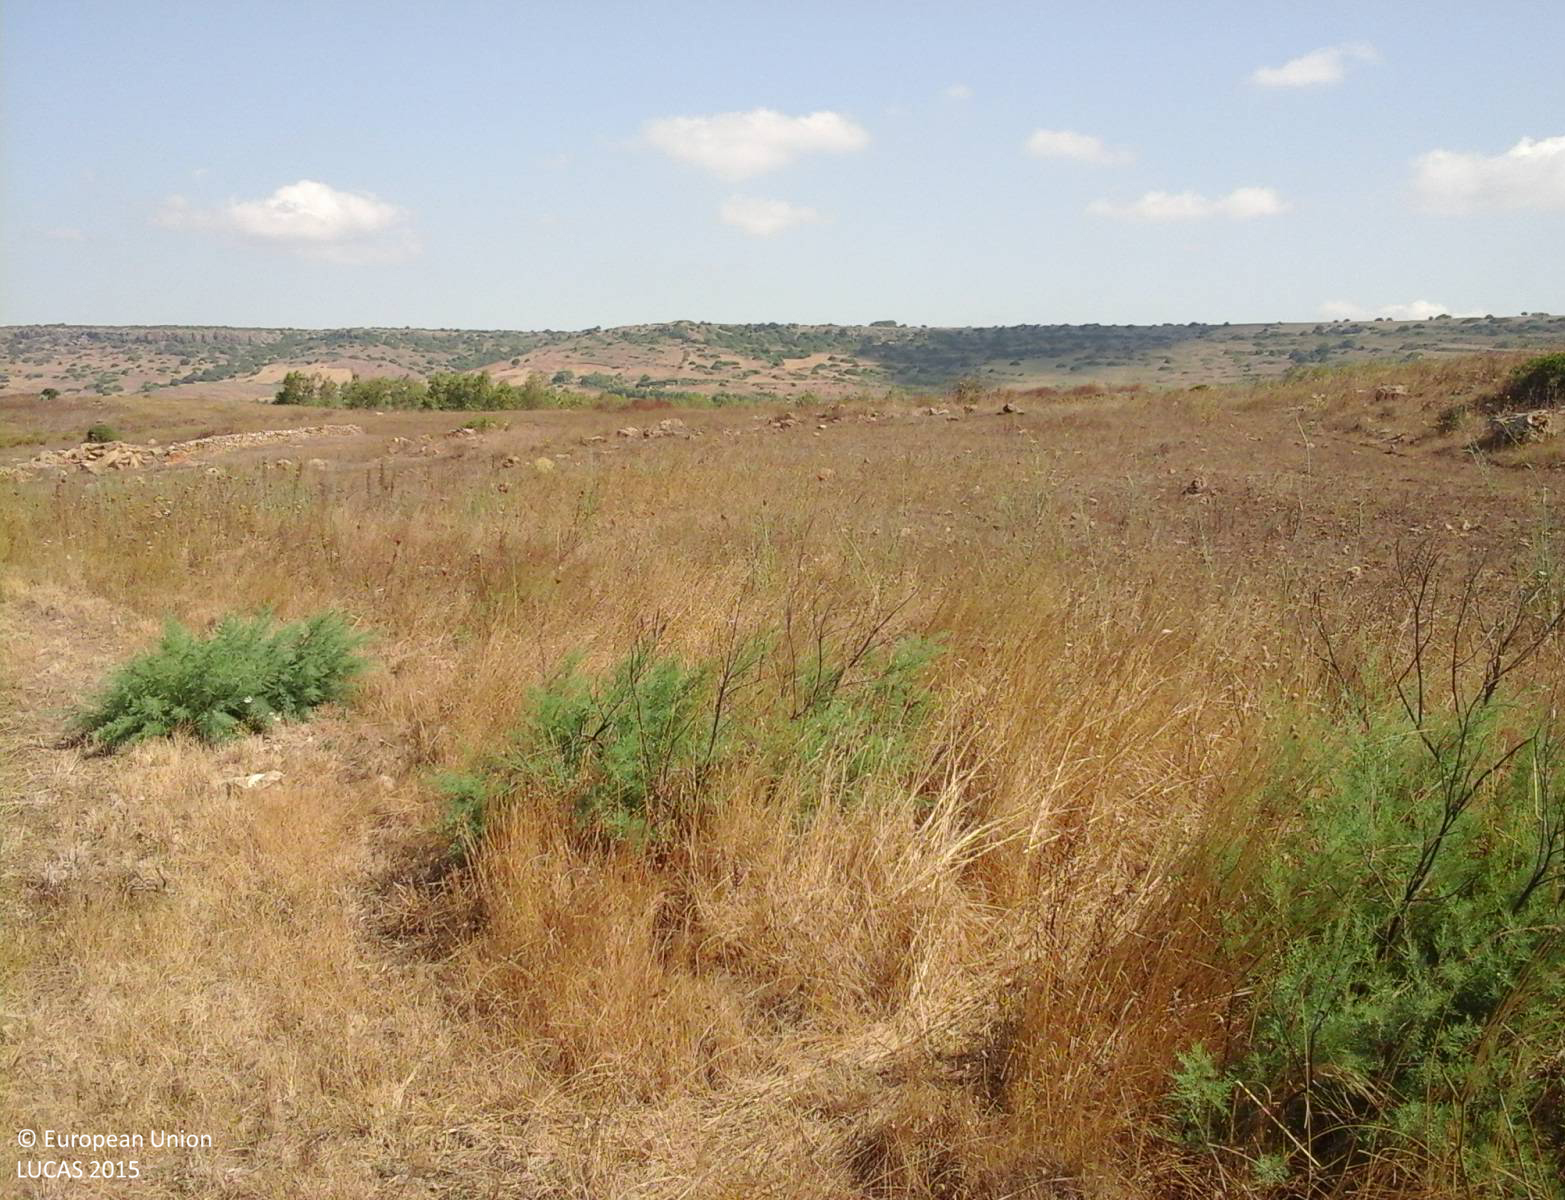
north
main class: Grassland
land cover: Spontaneously vegetated surfaces
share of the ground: > 75 %
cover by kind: herbaceous plants 100 %
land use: Agriculture (excluding fallow land and kitchen gardens)
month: July
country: IT
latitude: 39.6452
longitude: 8.8762
